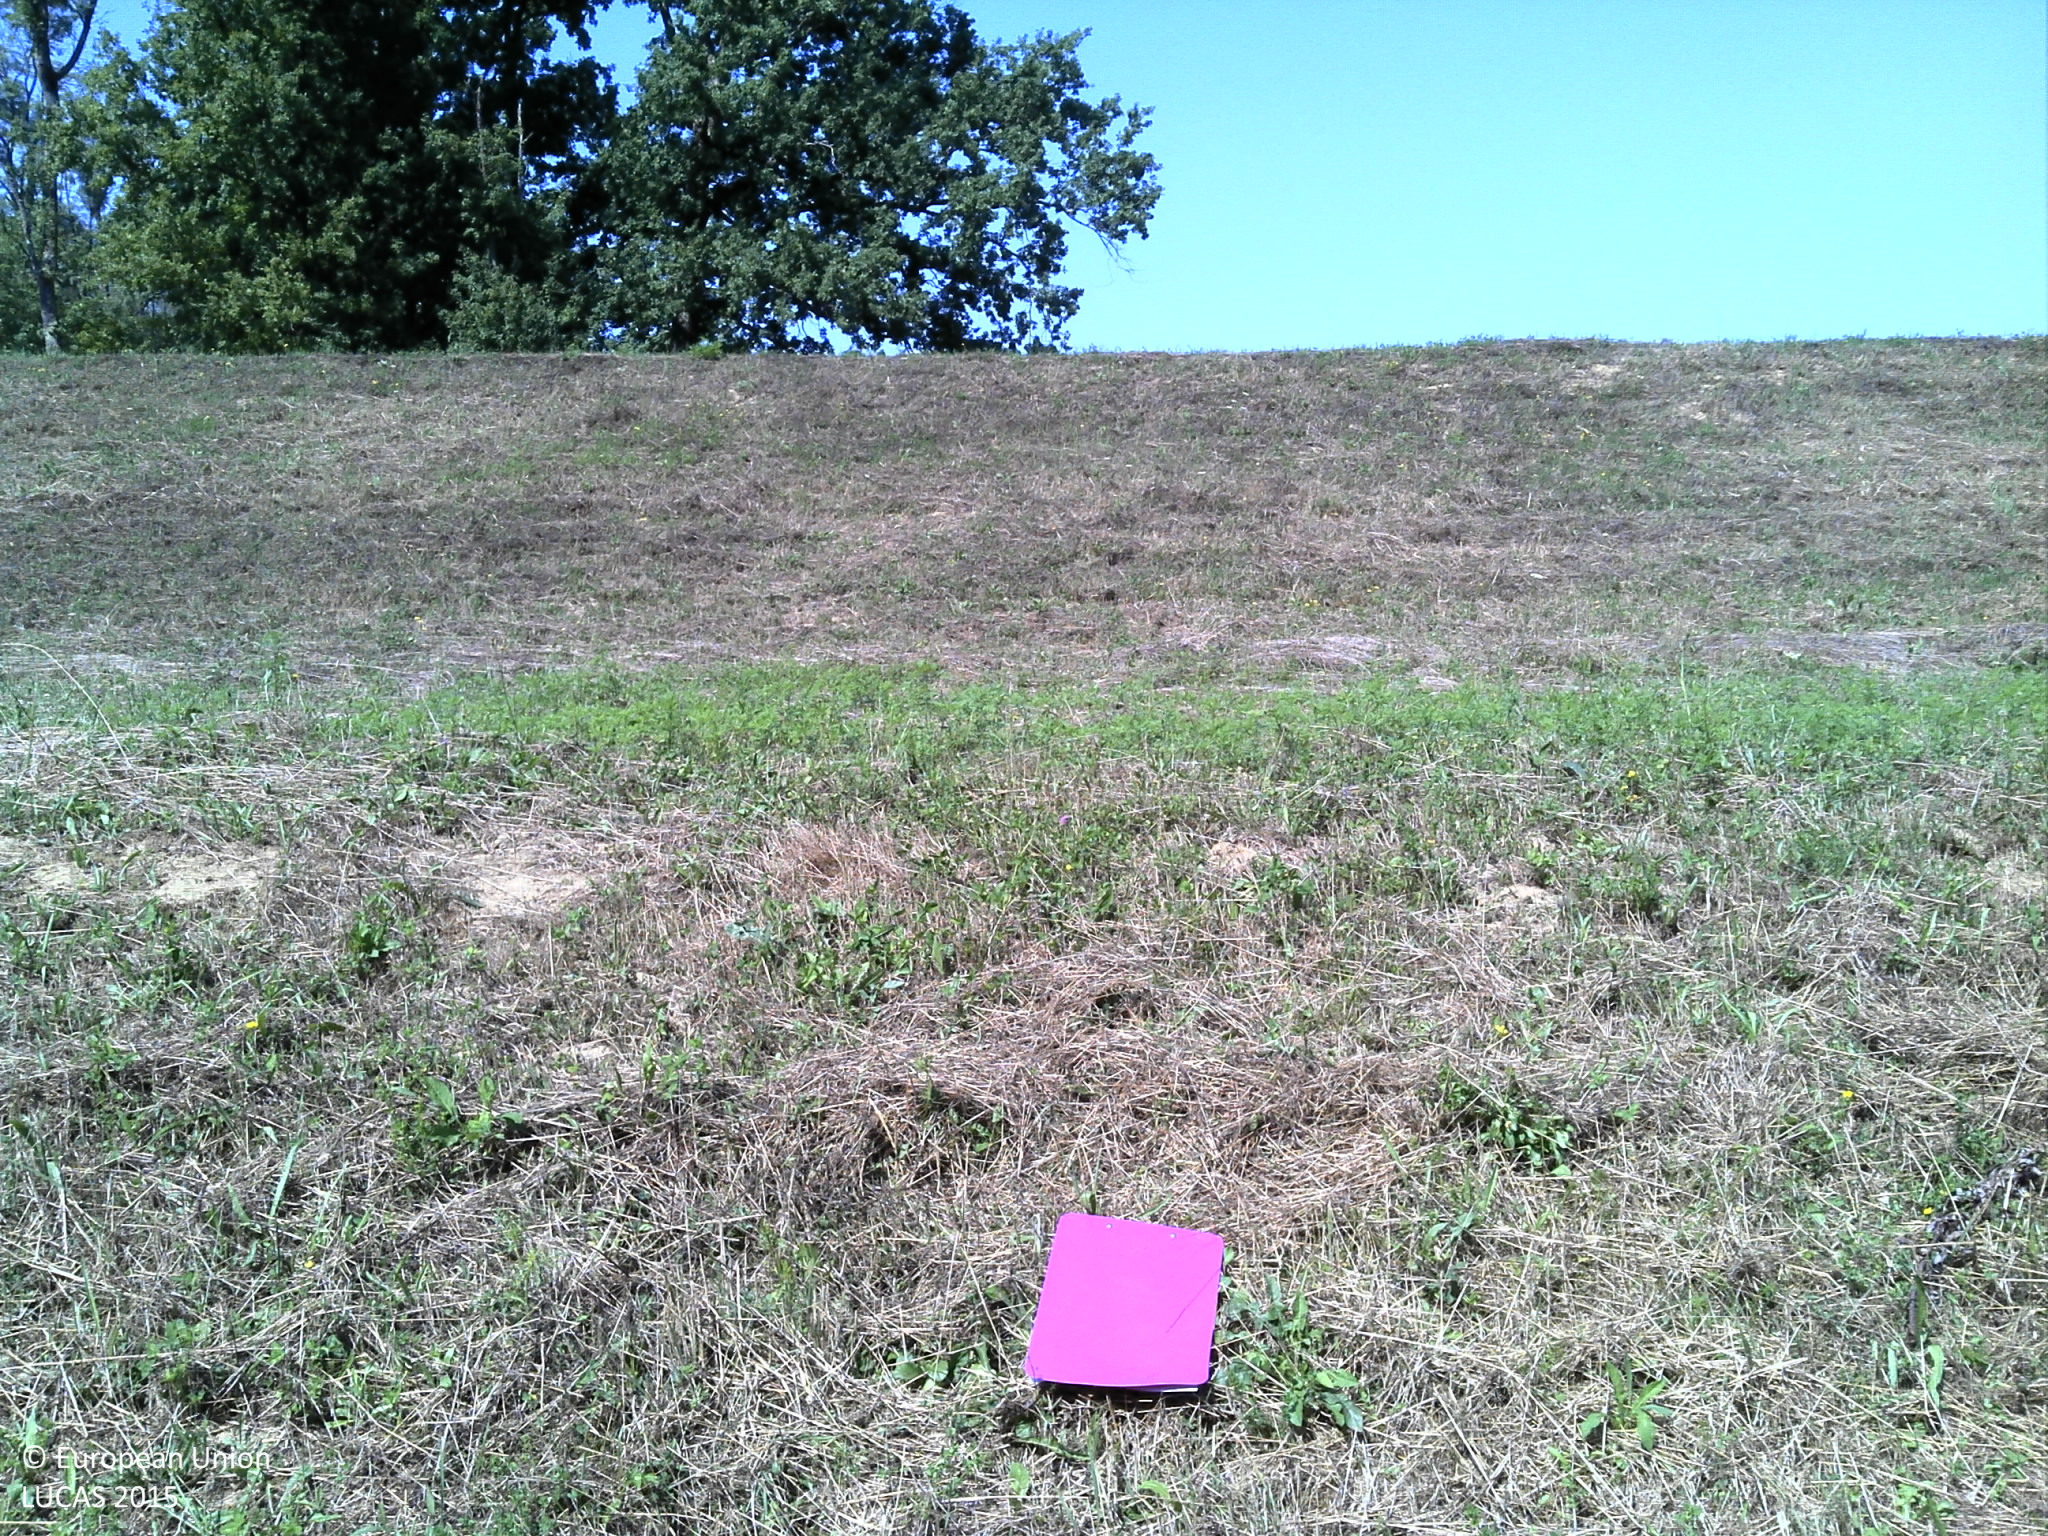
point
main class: Grassland
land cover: Grassland without tree/shrub cover
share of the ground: > 75 %
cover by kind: herbaceous plants 100 %
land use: Semi-natural and natural areas not in use
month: August
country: HR
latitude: 45.4810
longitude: 16.5613
